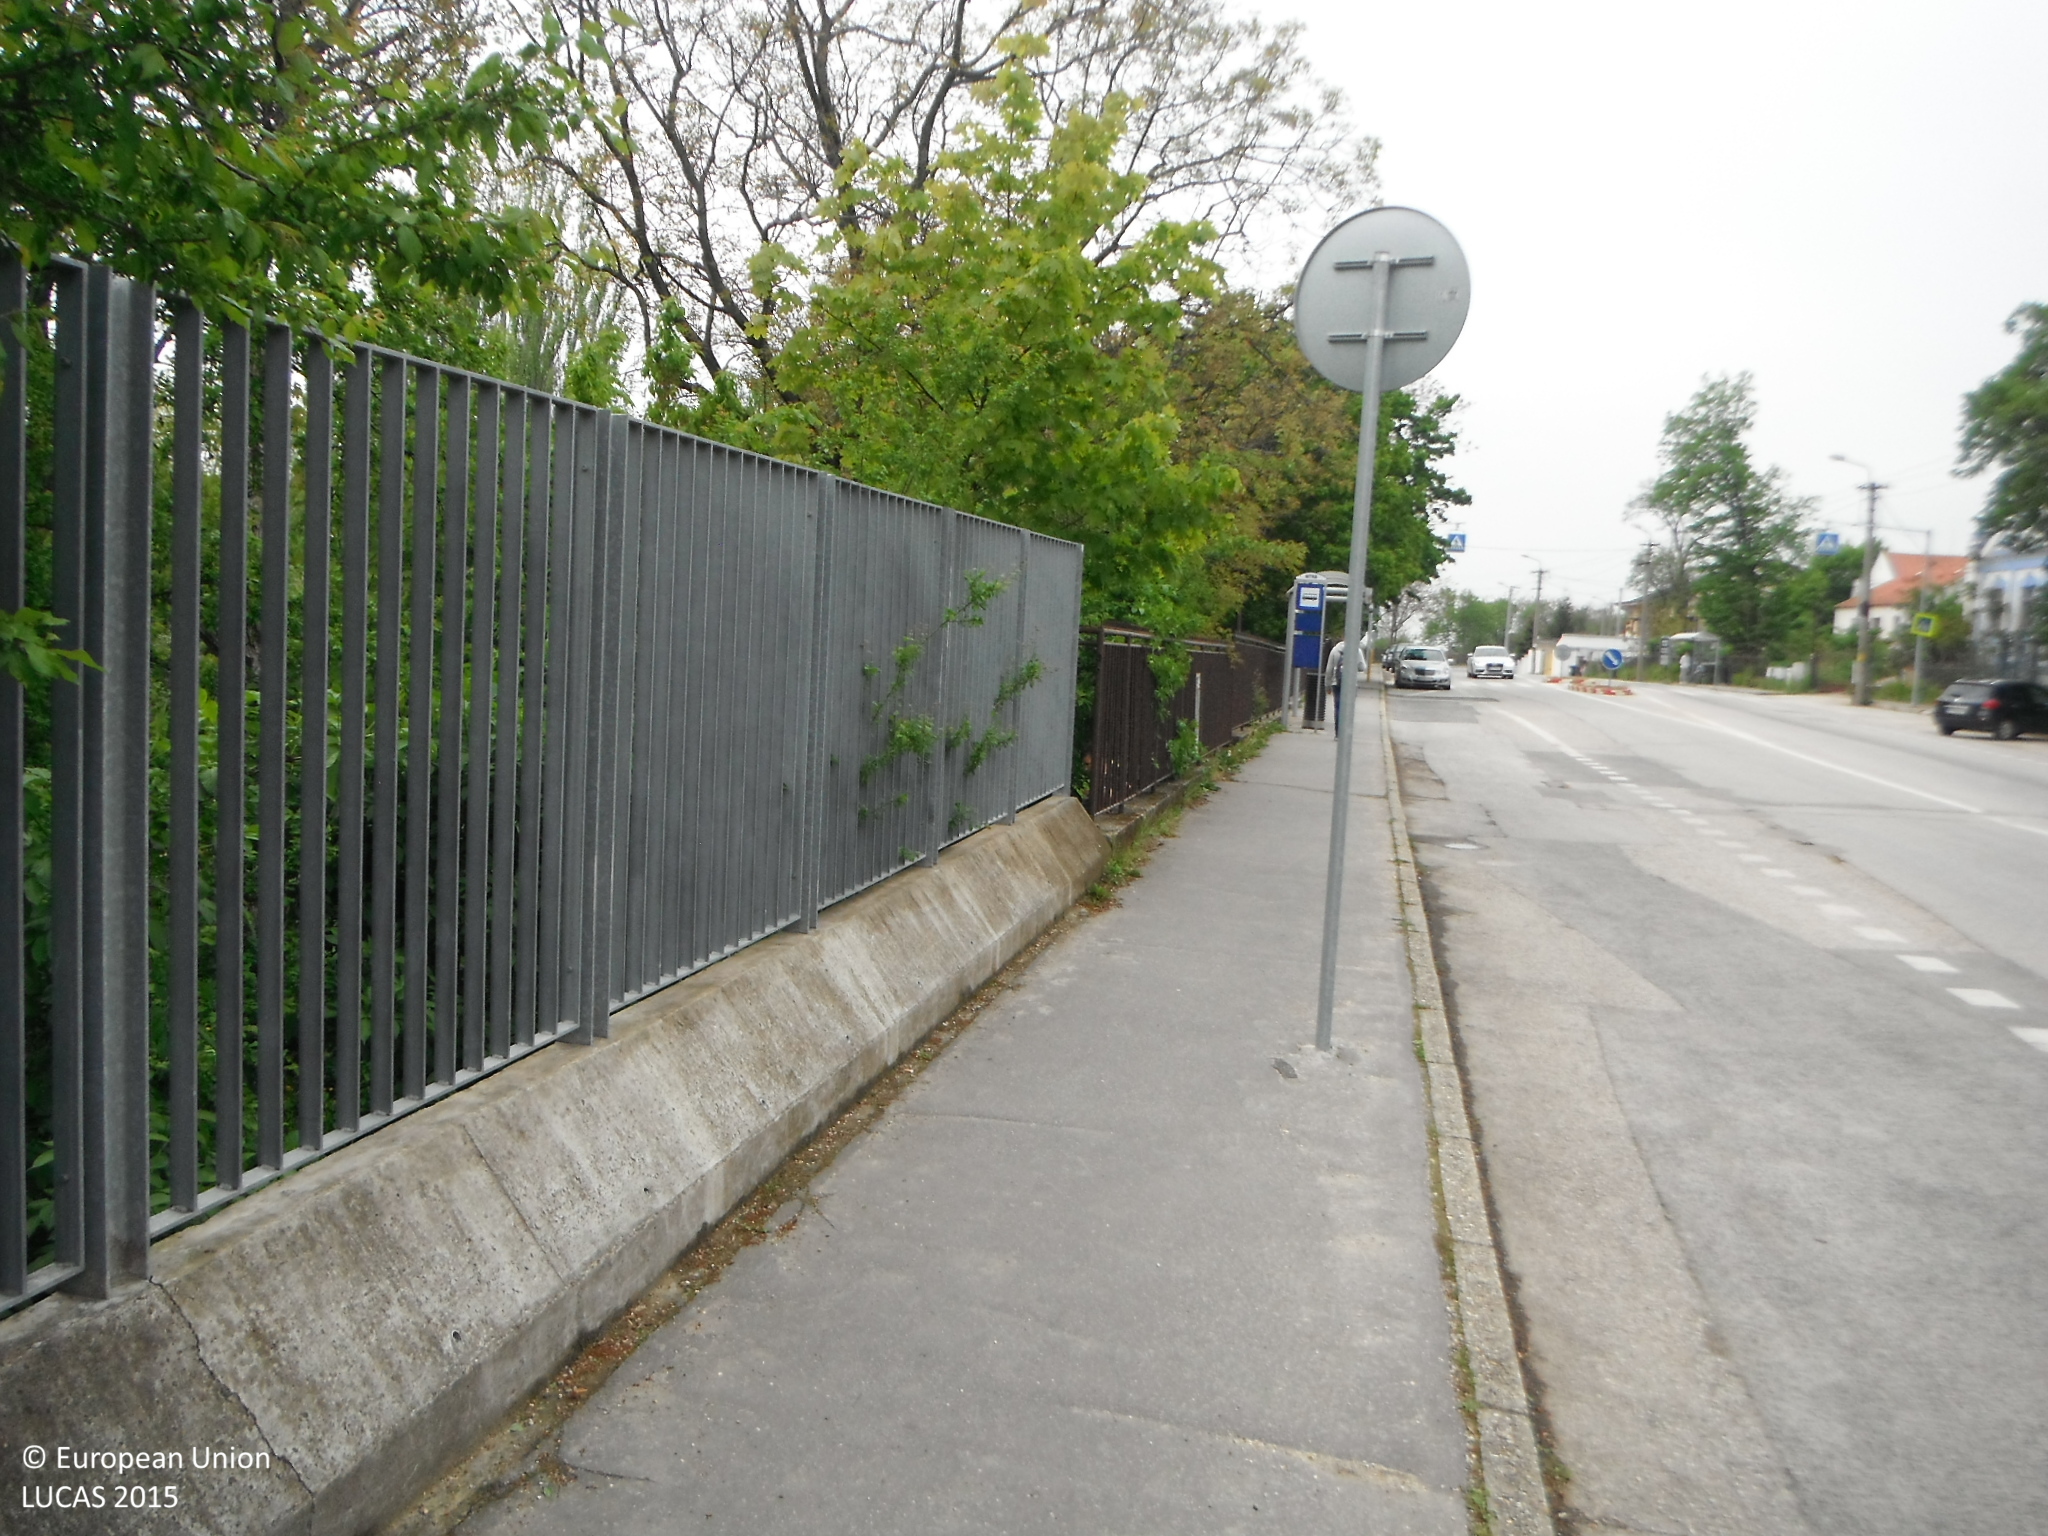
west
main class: Cropland
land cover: Other fruit trees and berries
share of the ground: > 75 %
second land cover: Grassland without tree/shrub cover
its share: > 75 %
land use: Kitchen garden
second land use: Amenities, museums, leisure
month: May
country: SK
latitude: 48.3235
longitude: 18.0924
